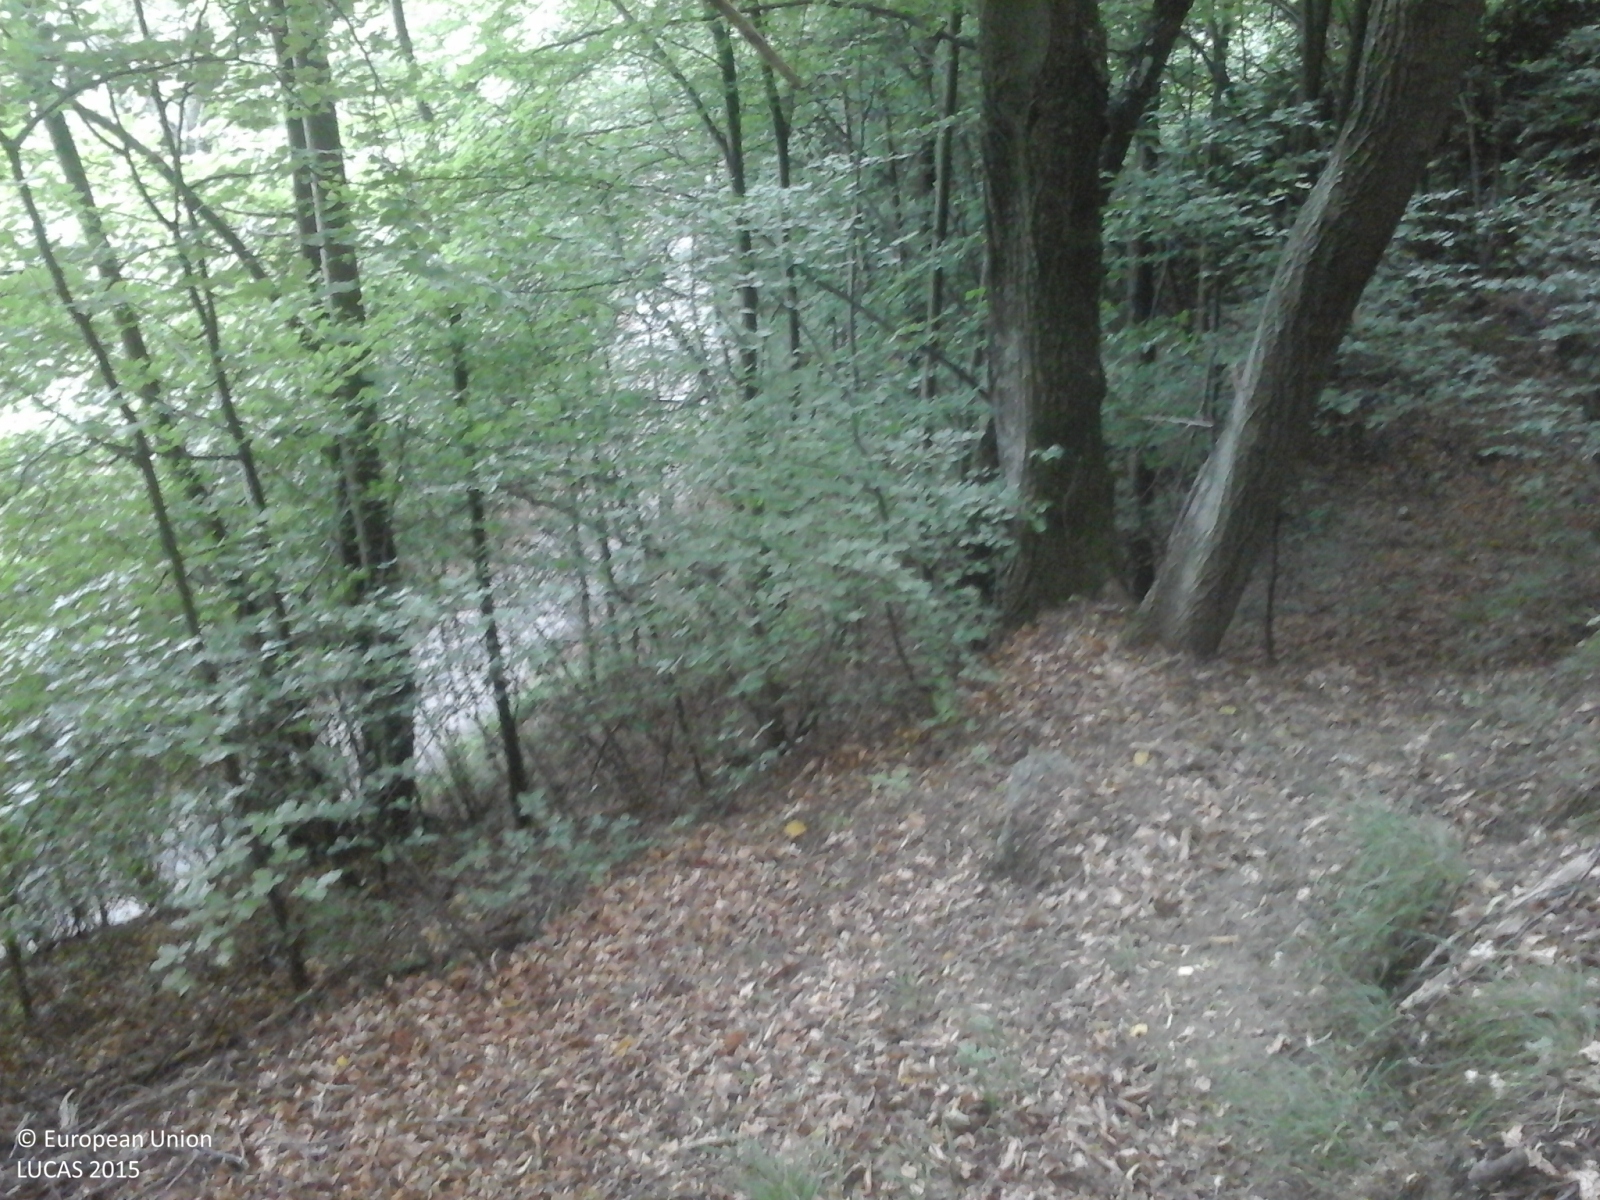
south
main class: Woodland
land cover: Broadleaved woodland
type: beech forest
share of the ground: > 75 %
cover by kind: broadleaved forest trees 100 %
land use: Forestry
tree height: > 5 m
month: July
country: IT
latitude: 45.1452
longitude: 7.2955
